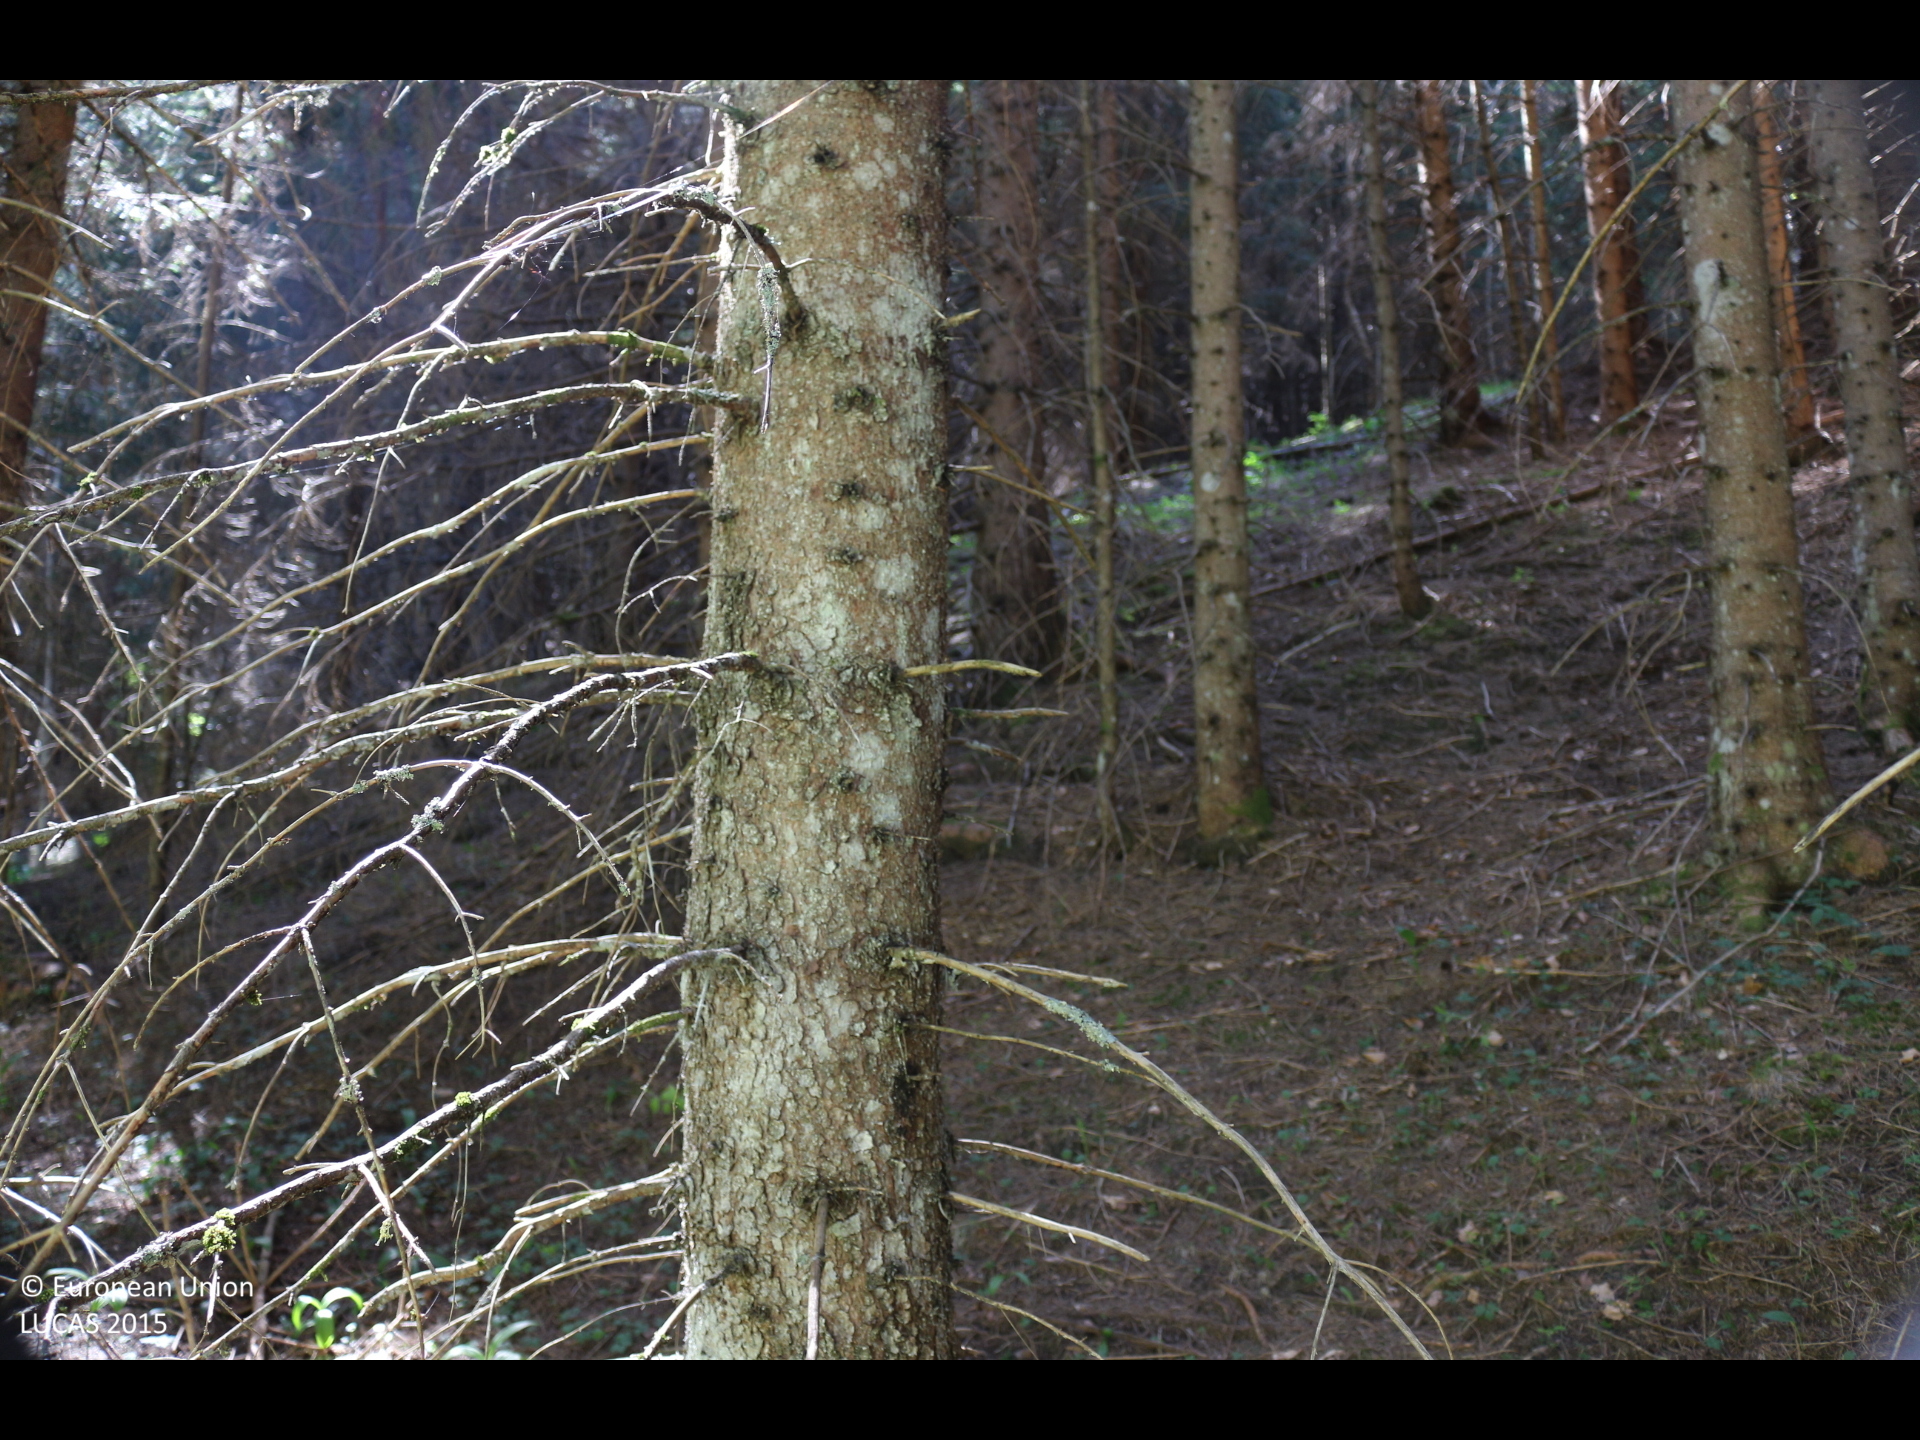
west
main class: Woodland
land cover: Spruce dominated coniferous woodland
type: alpine coniferous forest
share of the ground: > 75 %
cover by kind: coniferous forest trees 95 %, broadleaved forest trees 5 %
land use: Forestry
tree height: > 5 m
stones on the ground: < 10 %
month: May
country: AT
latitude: 46.4850
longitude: 14.2048
